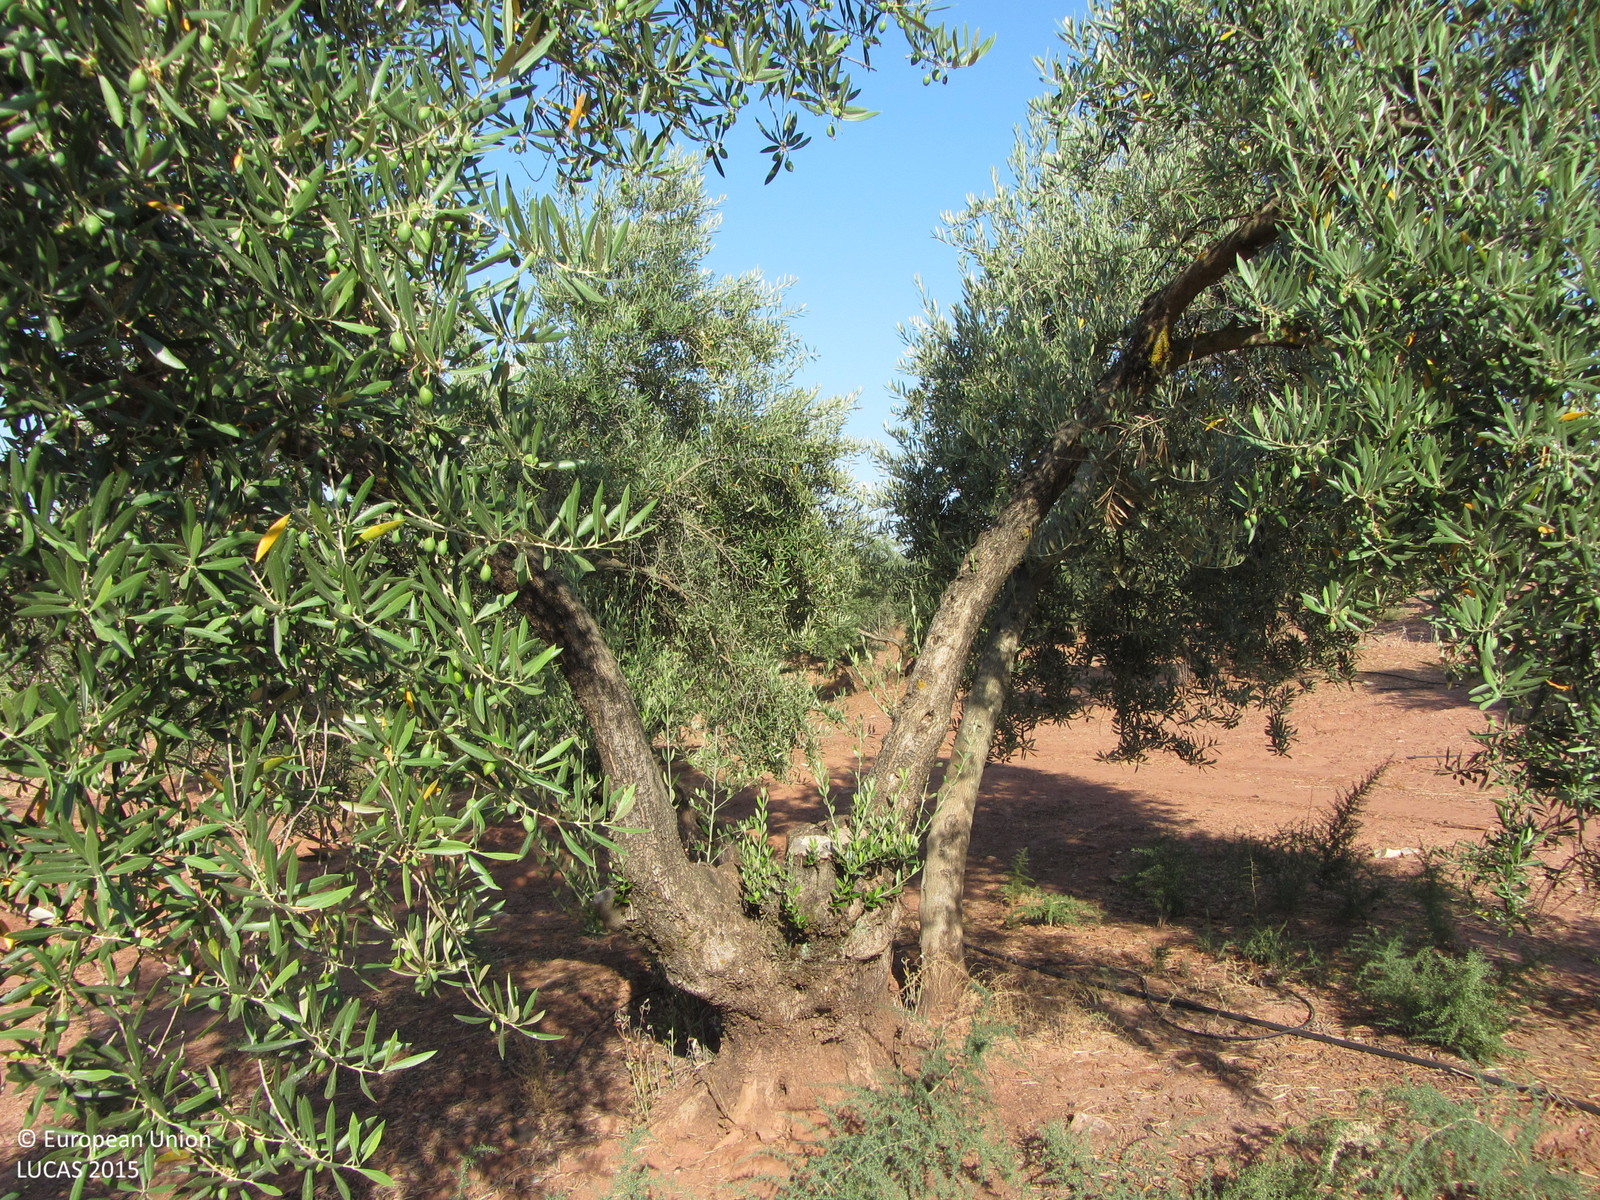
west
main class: Cropland
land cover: Olive groves
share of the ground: 25 - 50 %
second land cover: Other bare soil
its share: > 75 %
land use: Agriculture (excluding fallow land and kitchen gardens)
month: June
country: ES
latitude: 38.1864
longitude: -3.4180
